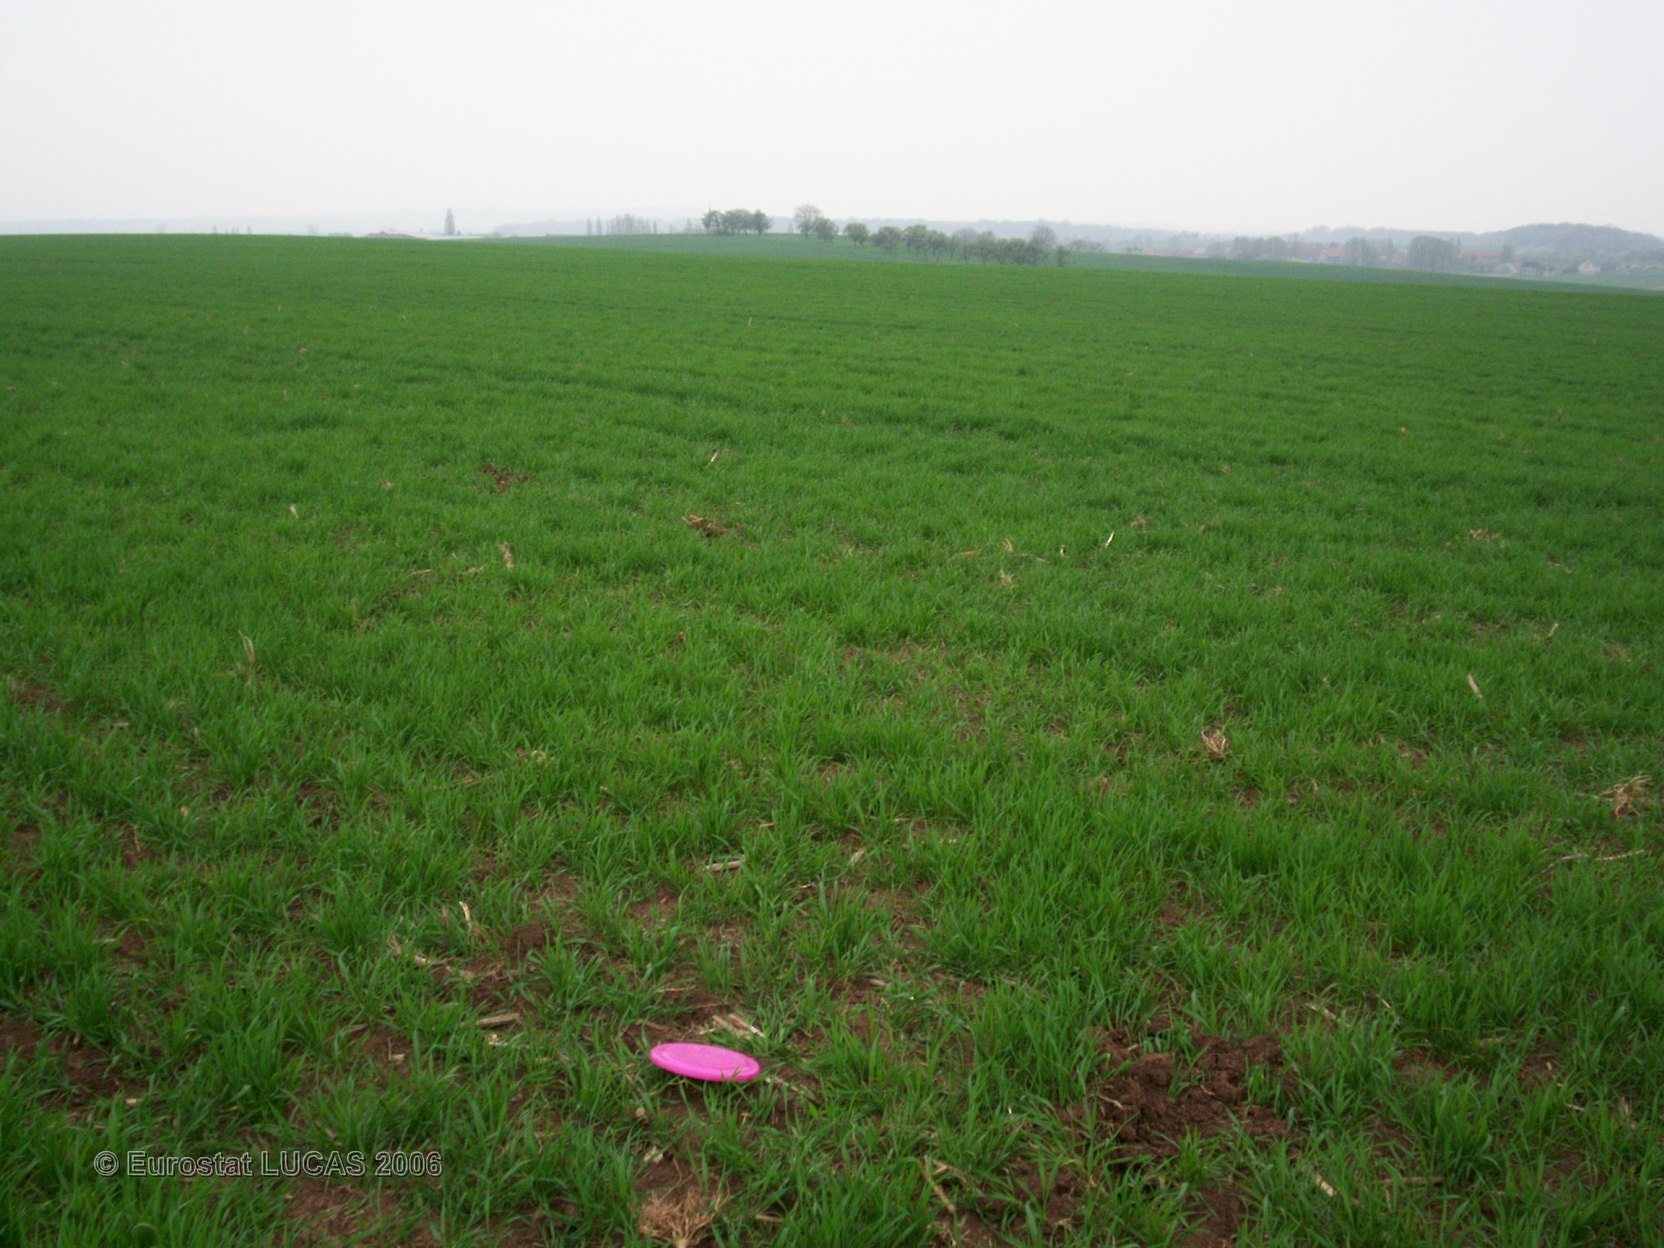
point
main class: Cropland
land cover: Common wheat
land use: Agriculture (excluding fallow land and kitchen gardens)
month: April
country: FR
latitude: 48.9496
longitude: 6.7367
